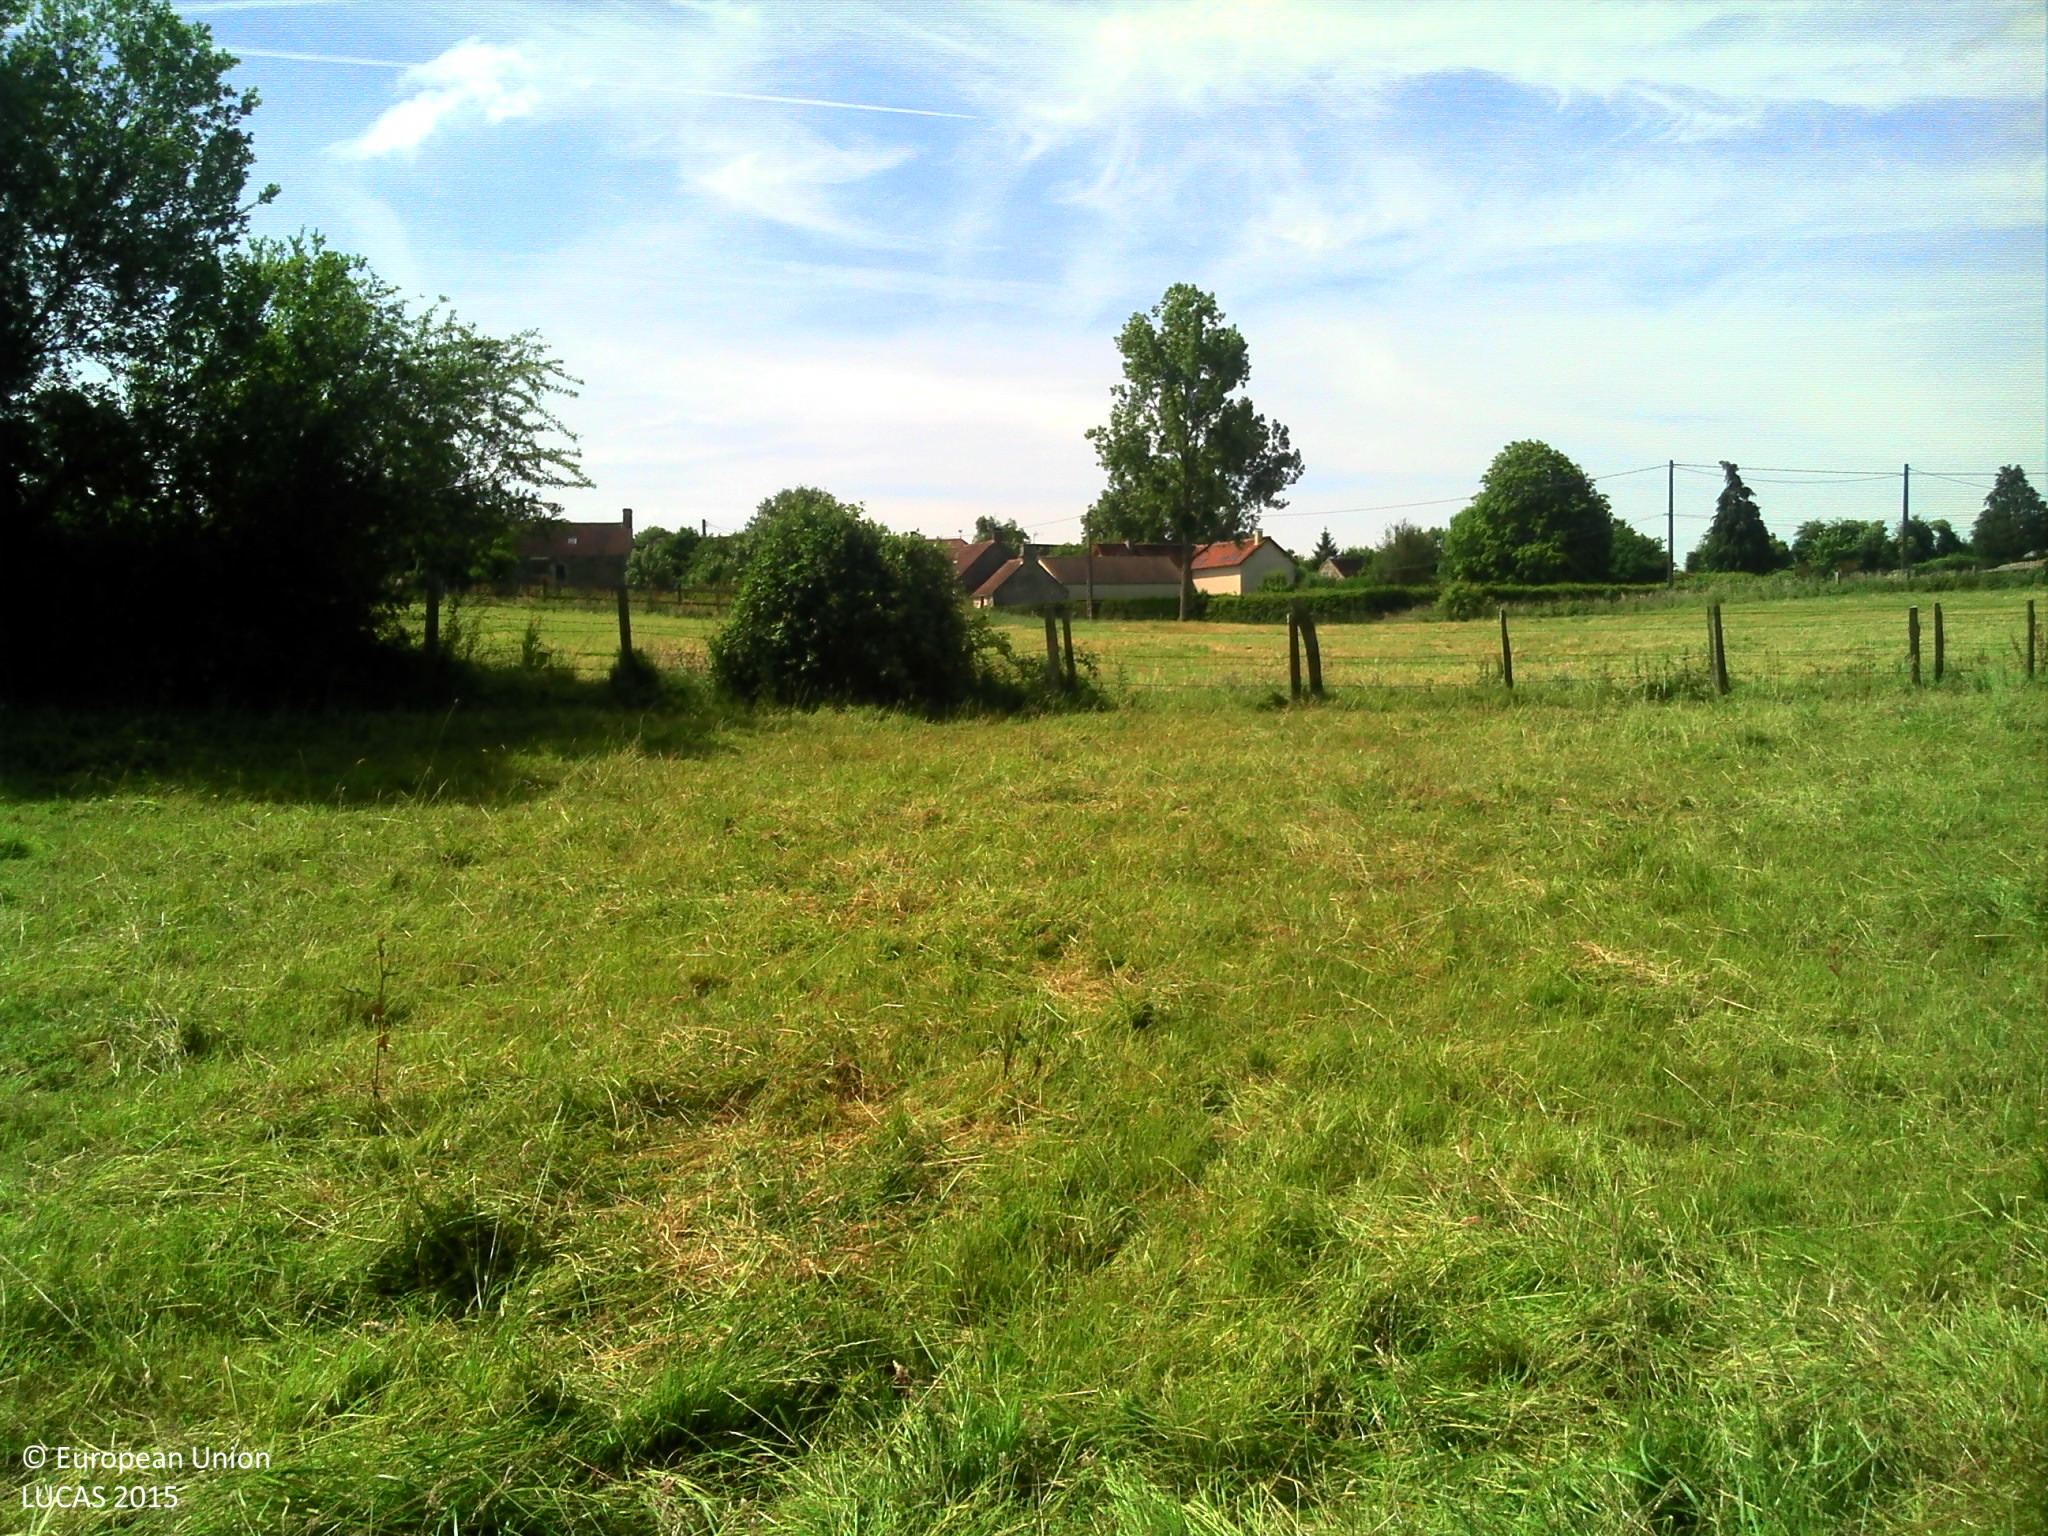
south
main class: Grassland
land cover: Grassland without tree/shrub cover
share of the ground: > 75 %
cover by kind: herbaceous plants 100 %
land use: Agriculture (excluding fallow land and kitchen gardens)
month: June
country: FR
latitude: 48.6277
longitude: -0.1119
